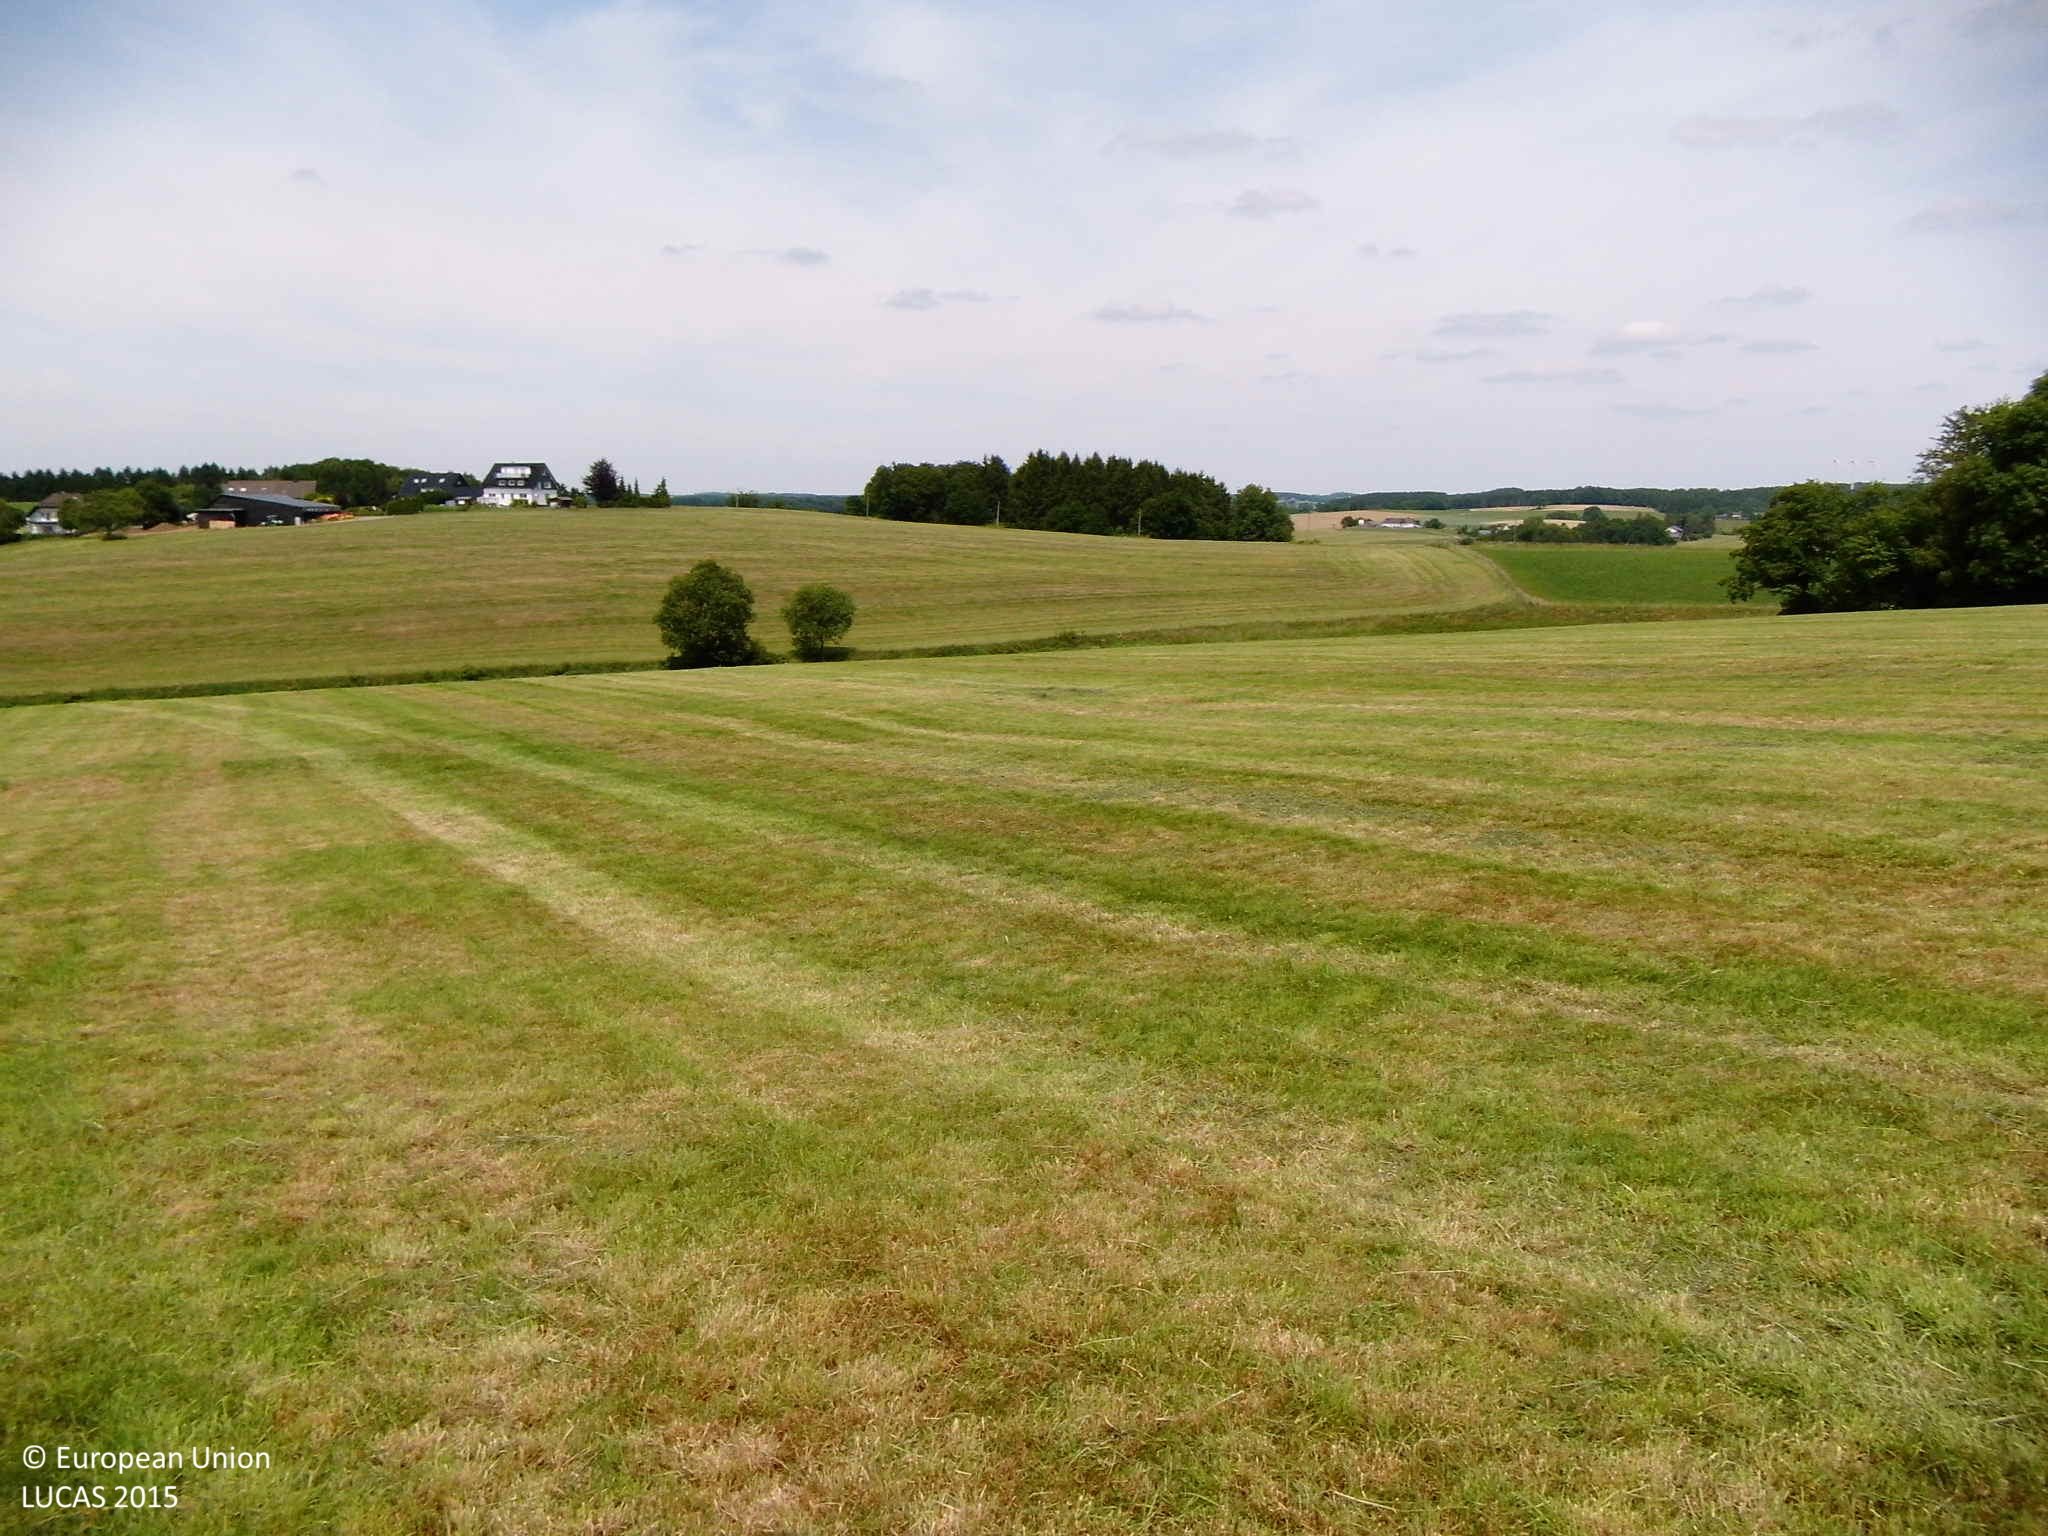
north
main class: Grassland
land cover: Grassland without tree/shrub cover
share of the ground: > 75 %
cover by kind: herbaceous plants 100 %
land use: Agriculture (excluding fallow land and kitchen gardens)
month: June
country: DE
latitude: 51.1090
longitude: 7.4435
